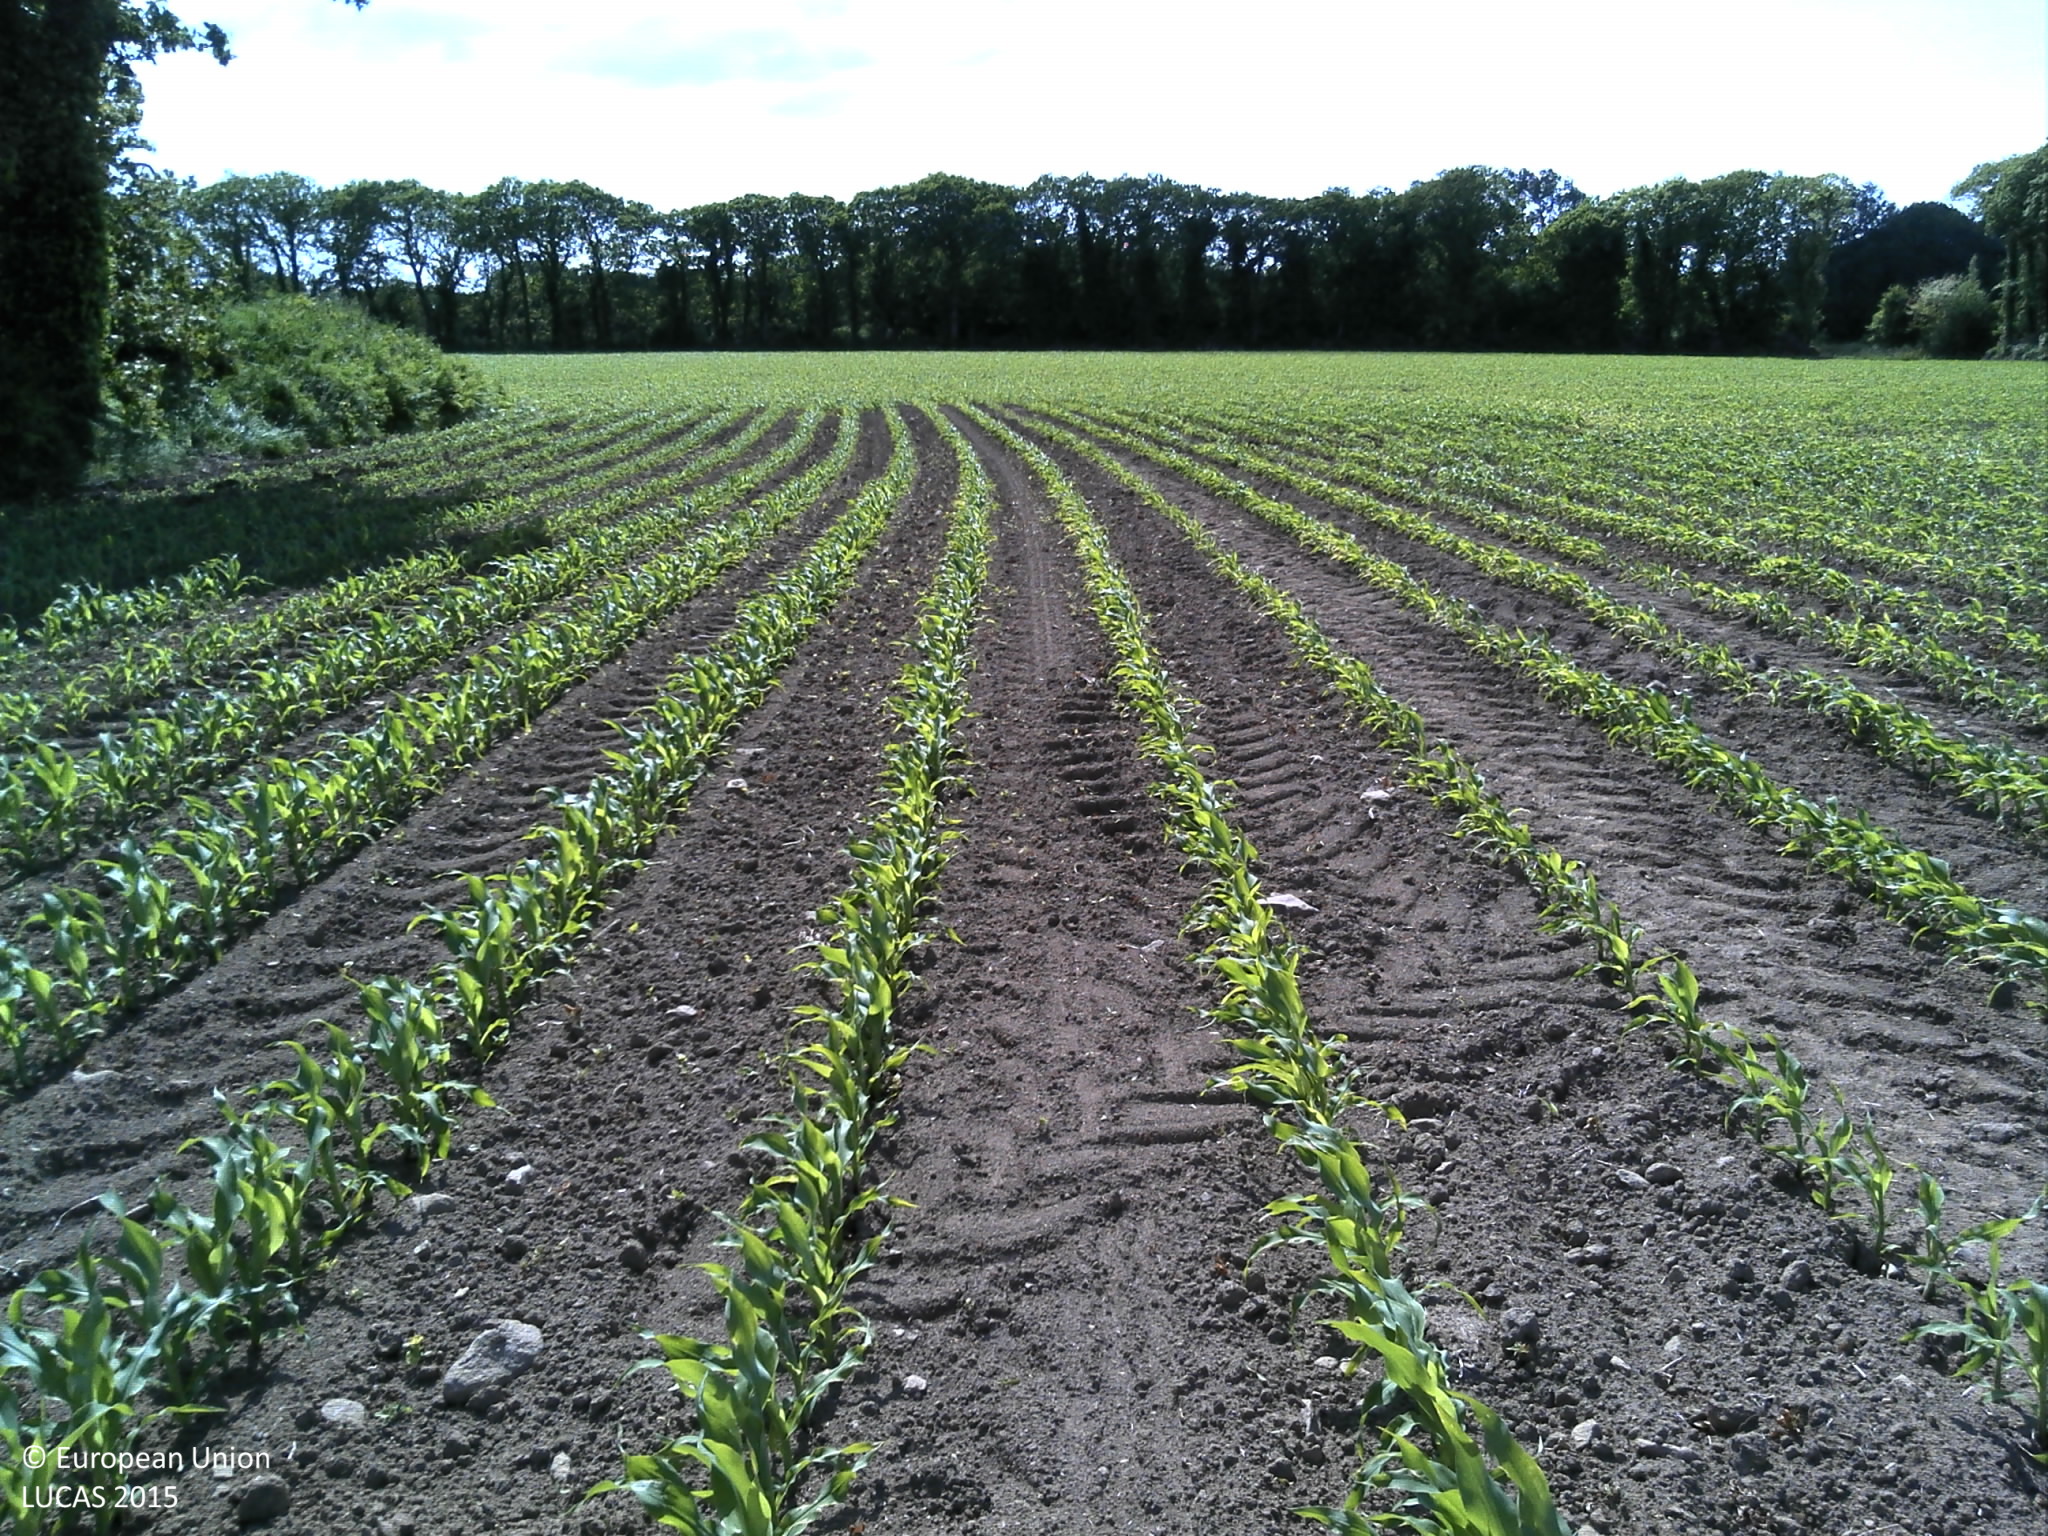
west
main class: Cropland
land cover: Maize
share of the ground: 50 - 75 %
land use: Agriculture (excluding fallow land and kitchen gardens)
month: June
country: FR
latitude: 48.0949
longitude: -4.3948
